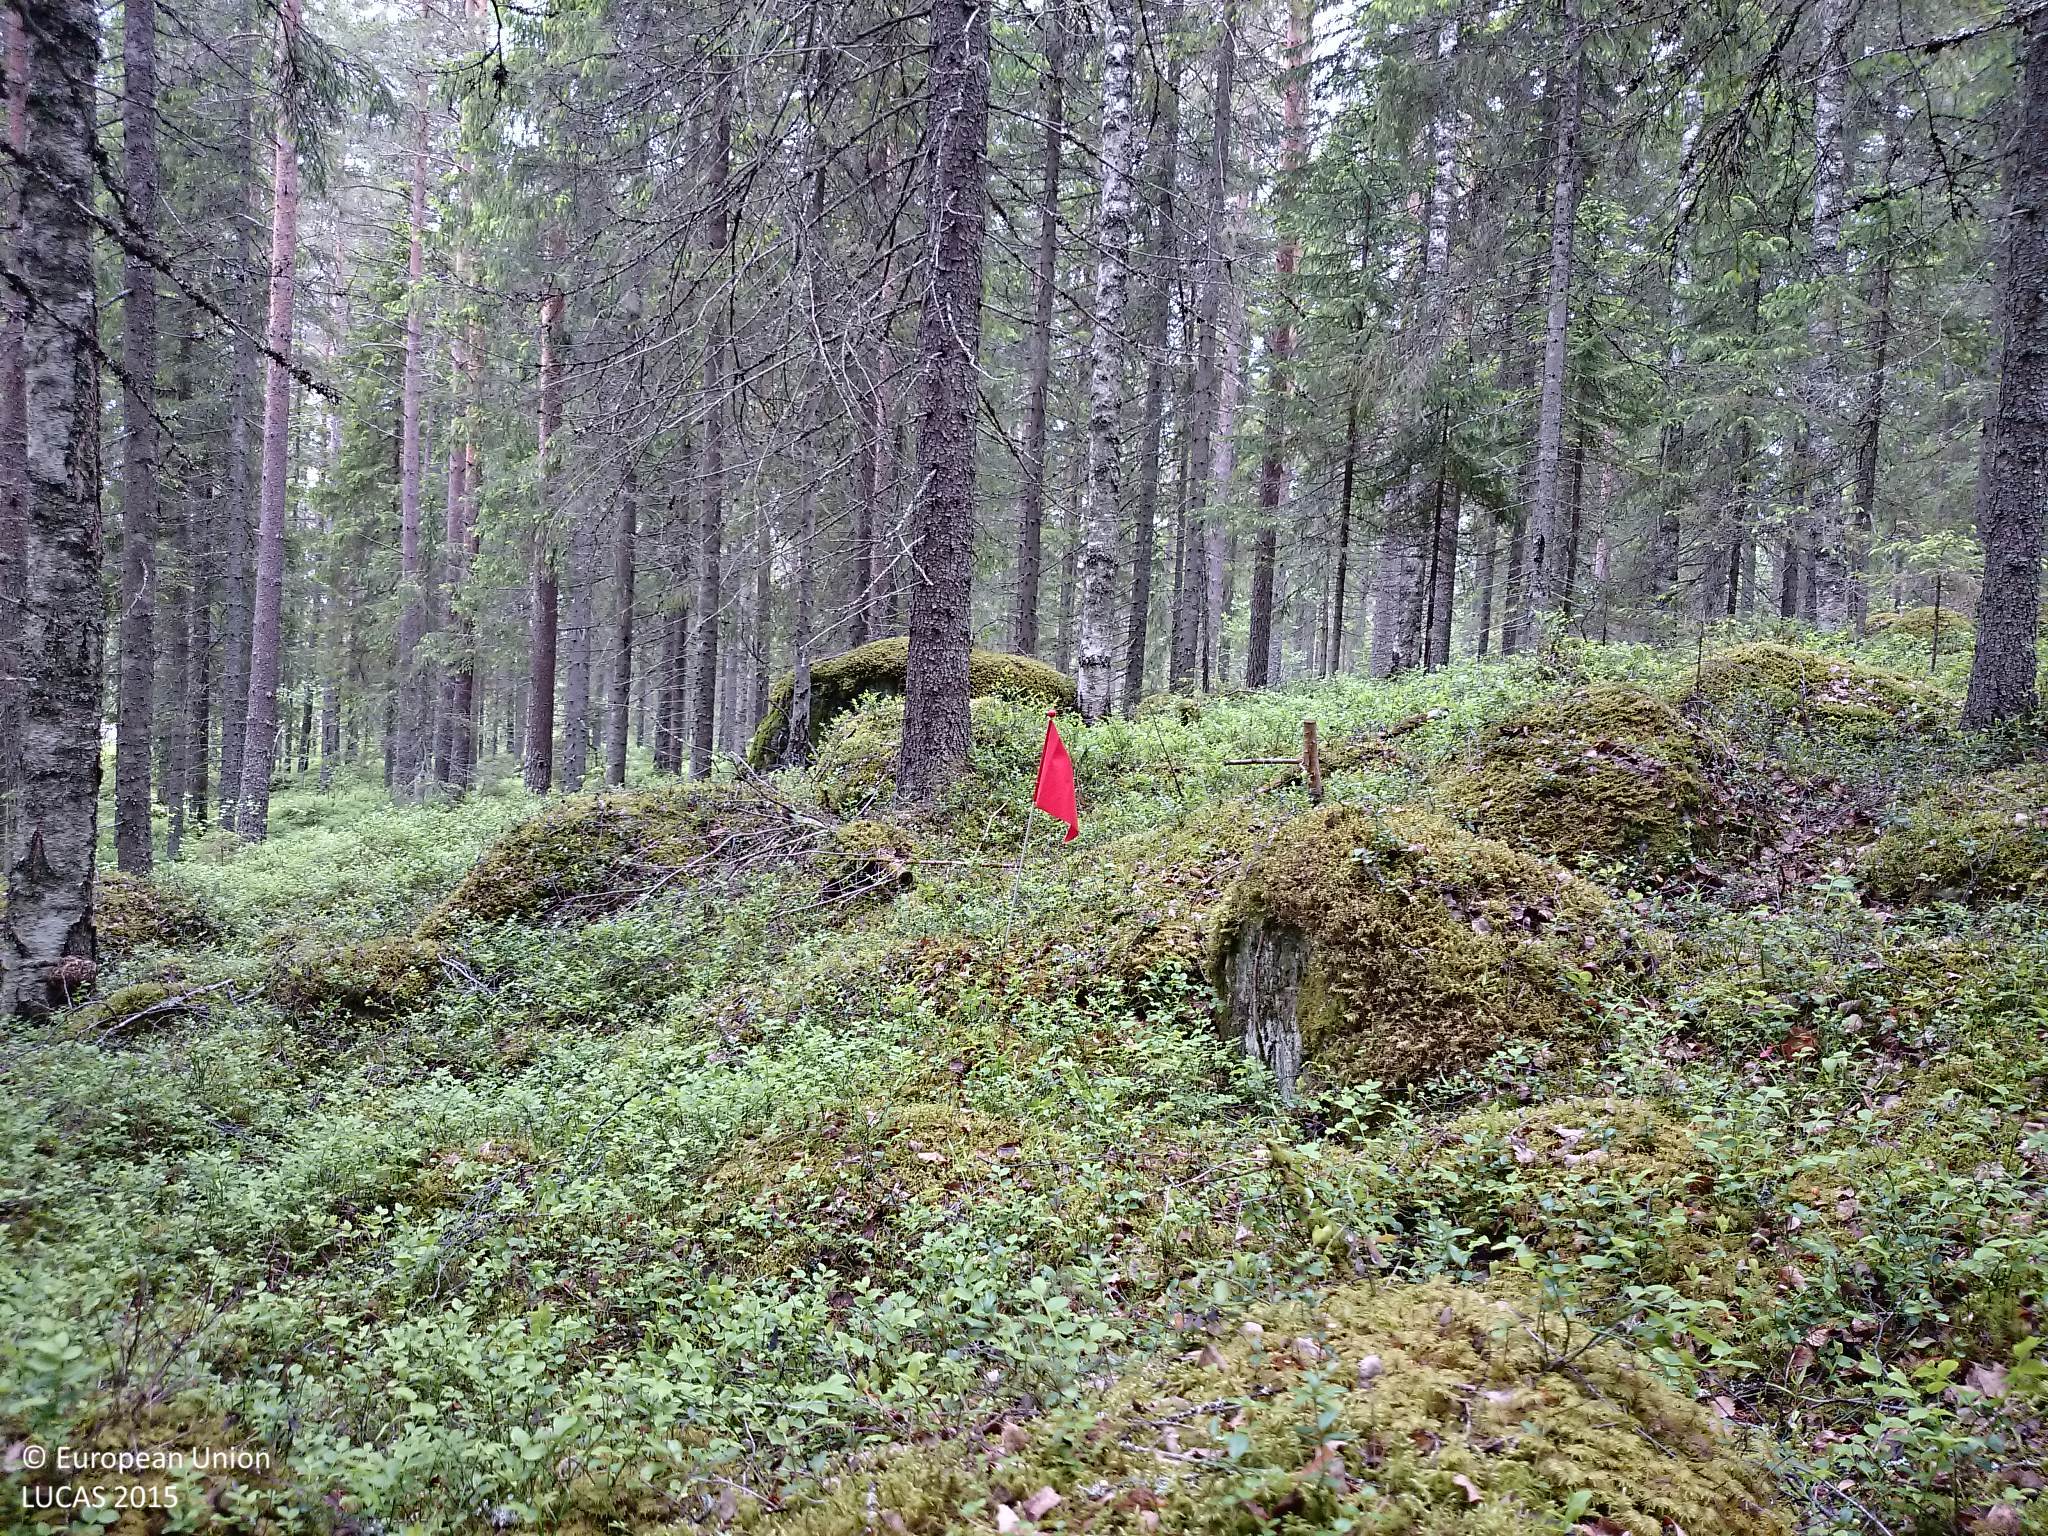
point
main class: Woodland
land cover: Spruce dominated mixed woodland
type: boreal forest
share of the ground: > 75 %
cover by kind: coniferous forest trees 60 %, broadleaved forest trees 20 %, shrubs 15 %, lichens and mosses 5 %
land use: Forestry
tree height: > 5 m
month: June
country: SE
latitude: 64.1308
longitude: 20.6430
